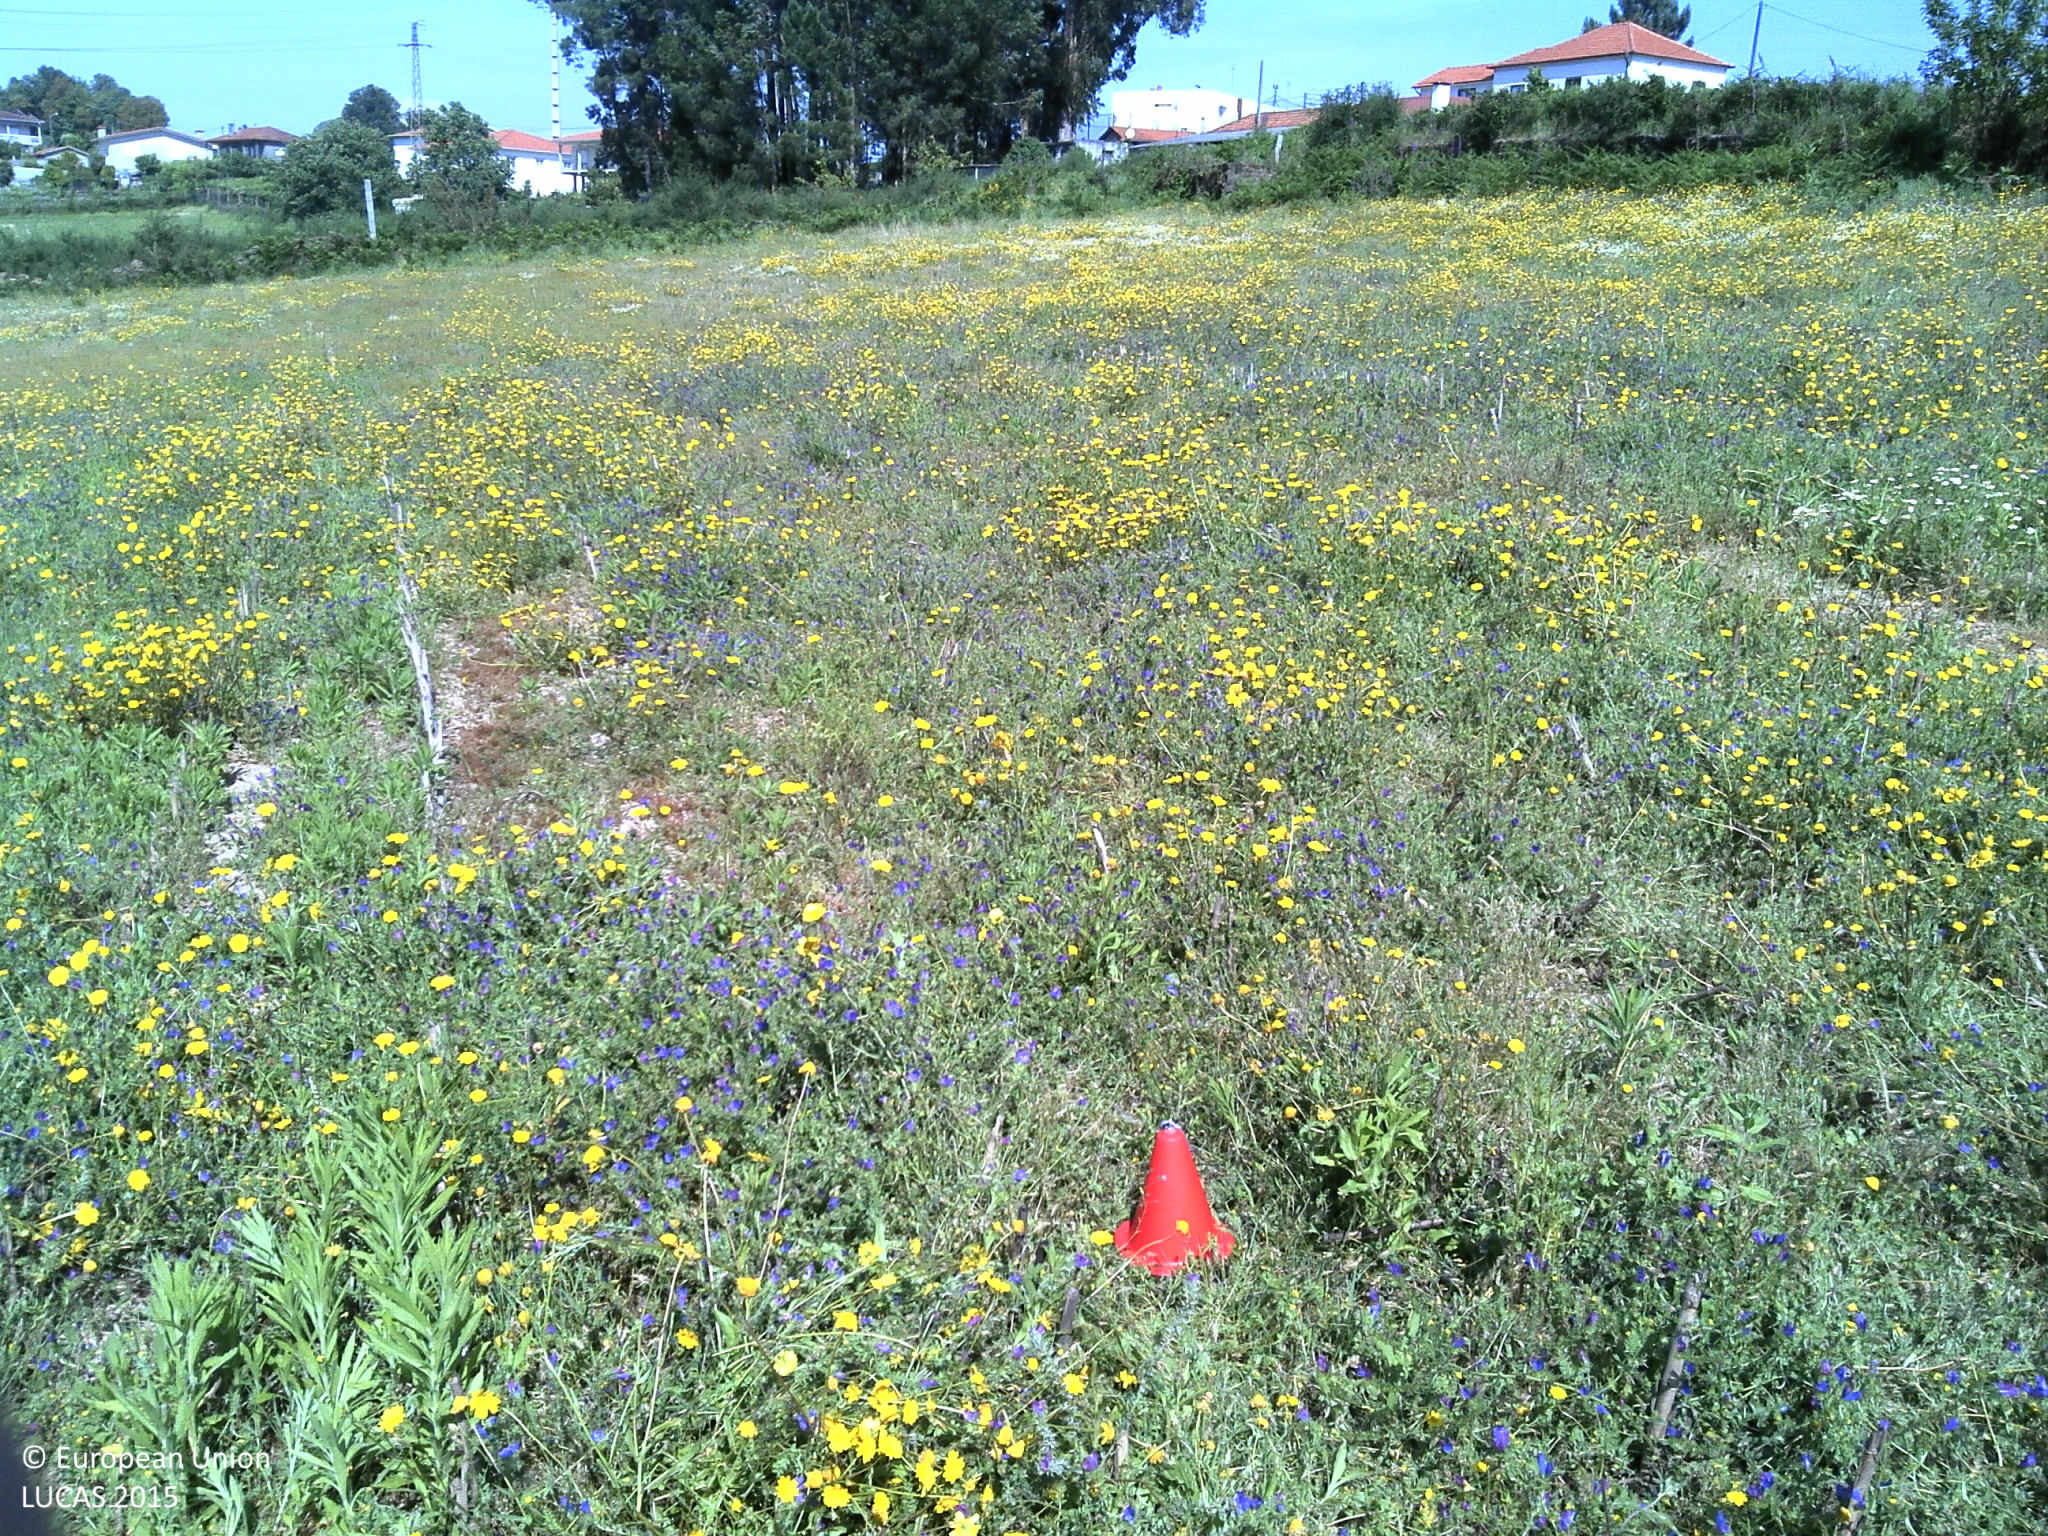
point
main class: Grassland
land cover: Grassland without tree/shrub cover
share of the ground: 50 - 75 %
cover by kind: herbaceous plants 95 %, unconsolidated bare surface 5 %
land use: Agriculture (excluding fallow land and kitchen gardens)
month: May
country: PT
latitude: 41.3570
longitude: -8.5011
